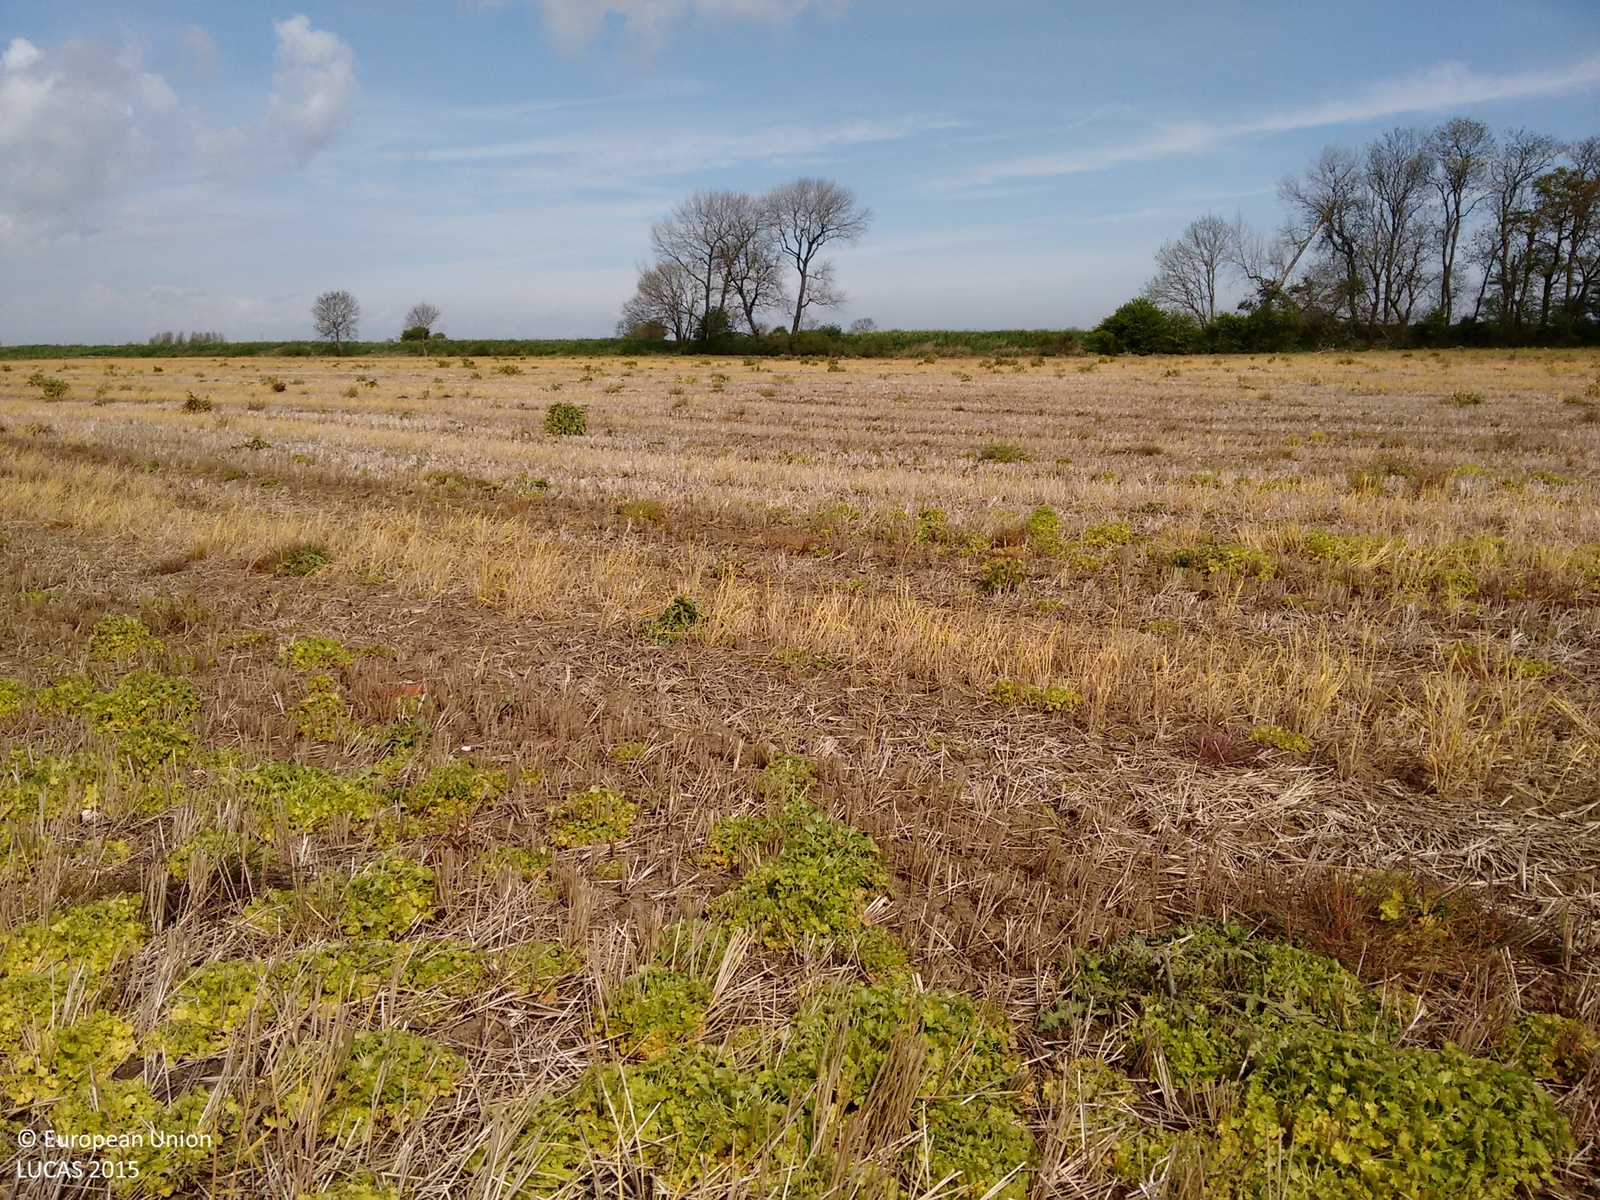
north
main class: Grassland
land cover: Spontaneously vegetated surfaces
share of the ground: 25 - 50 %
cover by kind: herbaceous plants 60 %, unconsolidated bare surface 40 %
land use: Agriculture (excluding fallow land and kitchen gardens)
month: May
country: GB
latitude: 53.3599
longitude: 0.1275
